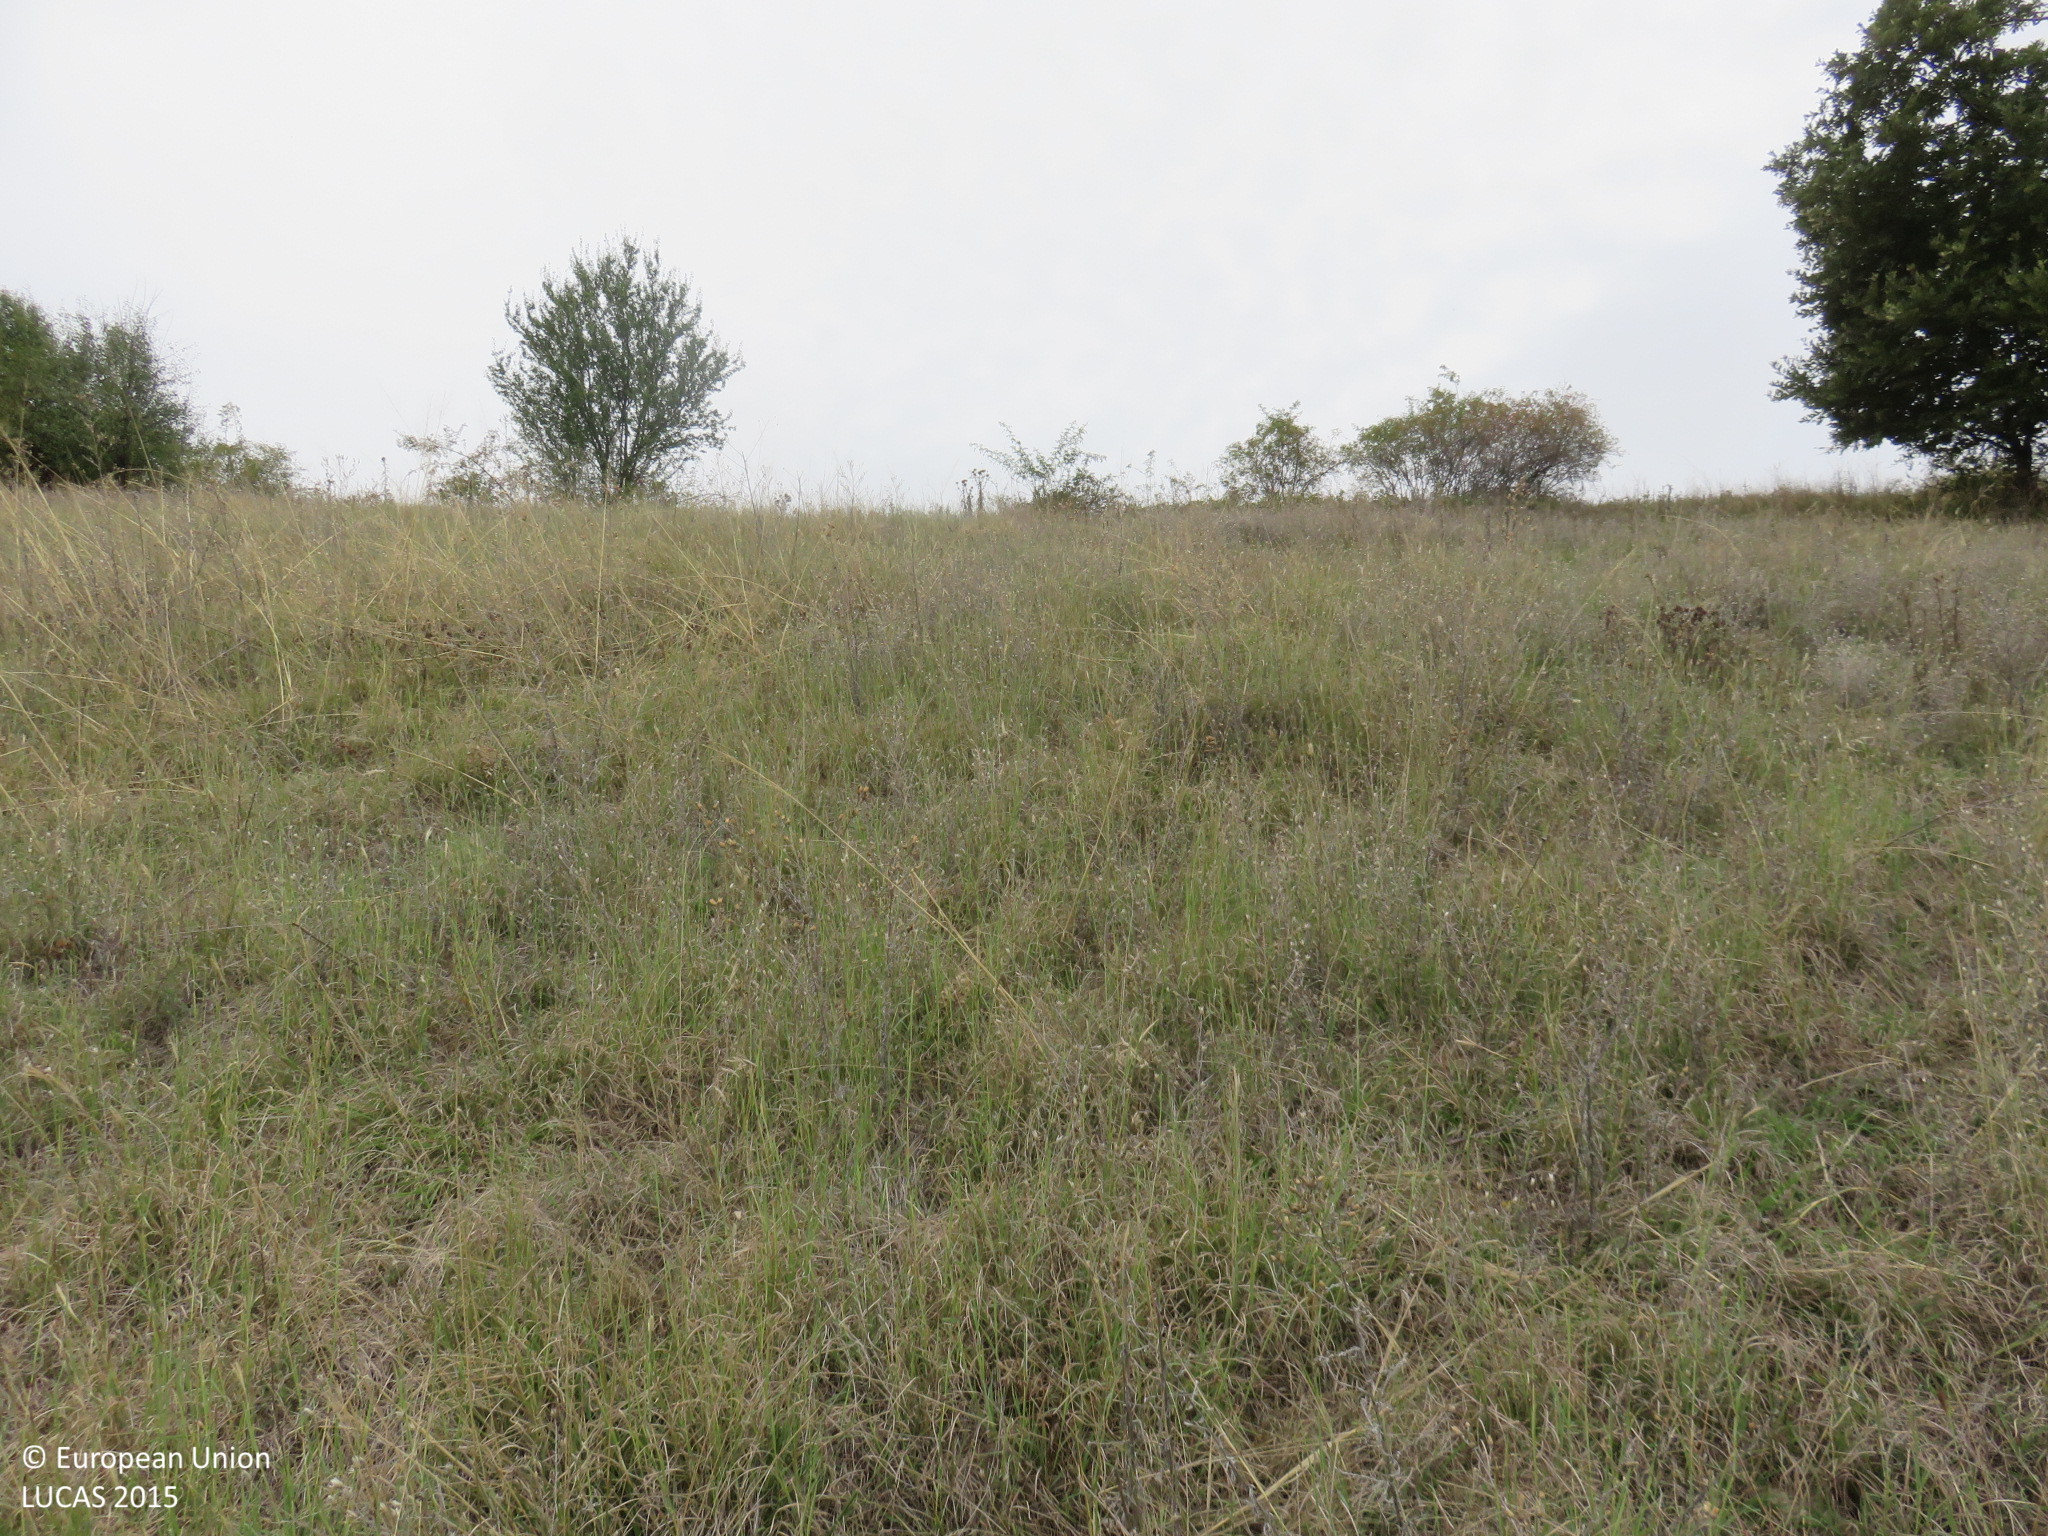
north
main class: Grassland
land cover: Grassland with sparse tree/shrub cover
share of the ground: > 75 %
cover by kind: herbaceous plants 90 %, broadleaved forest trees 5 %, shrubs 5 %
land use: Agriculture (excluding fallow land and kitchen gardens)
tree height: < 5 m
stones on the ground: 10 - 25 %
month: September
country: BG
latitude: 43.1776
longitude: 24.8898
